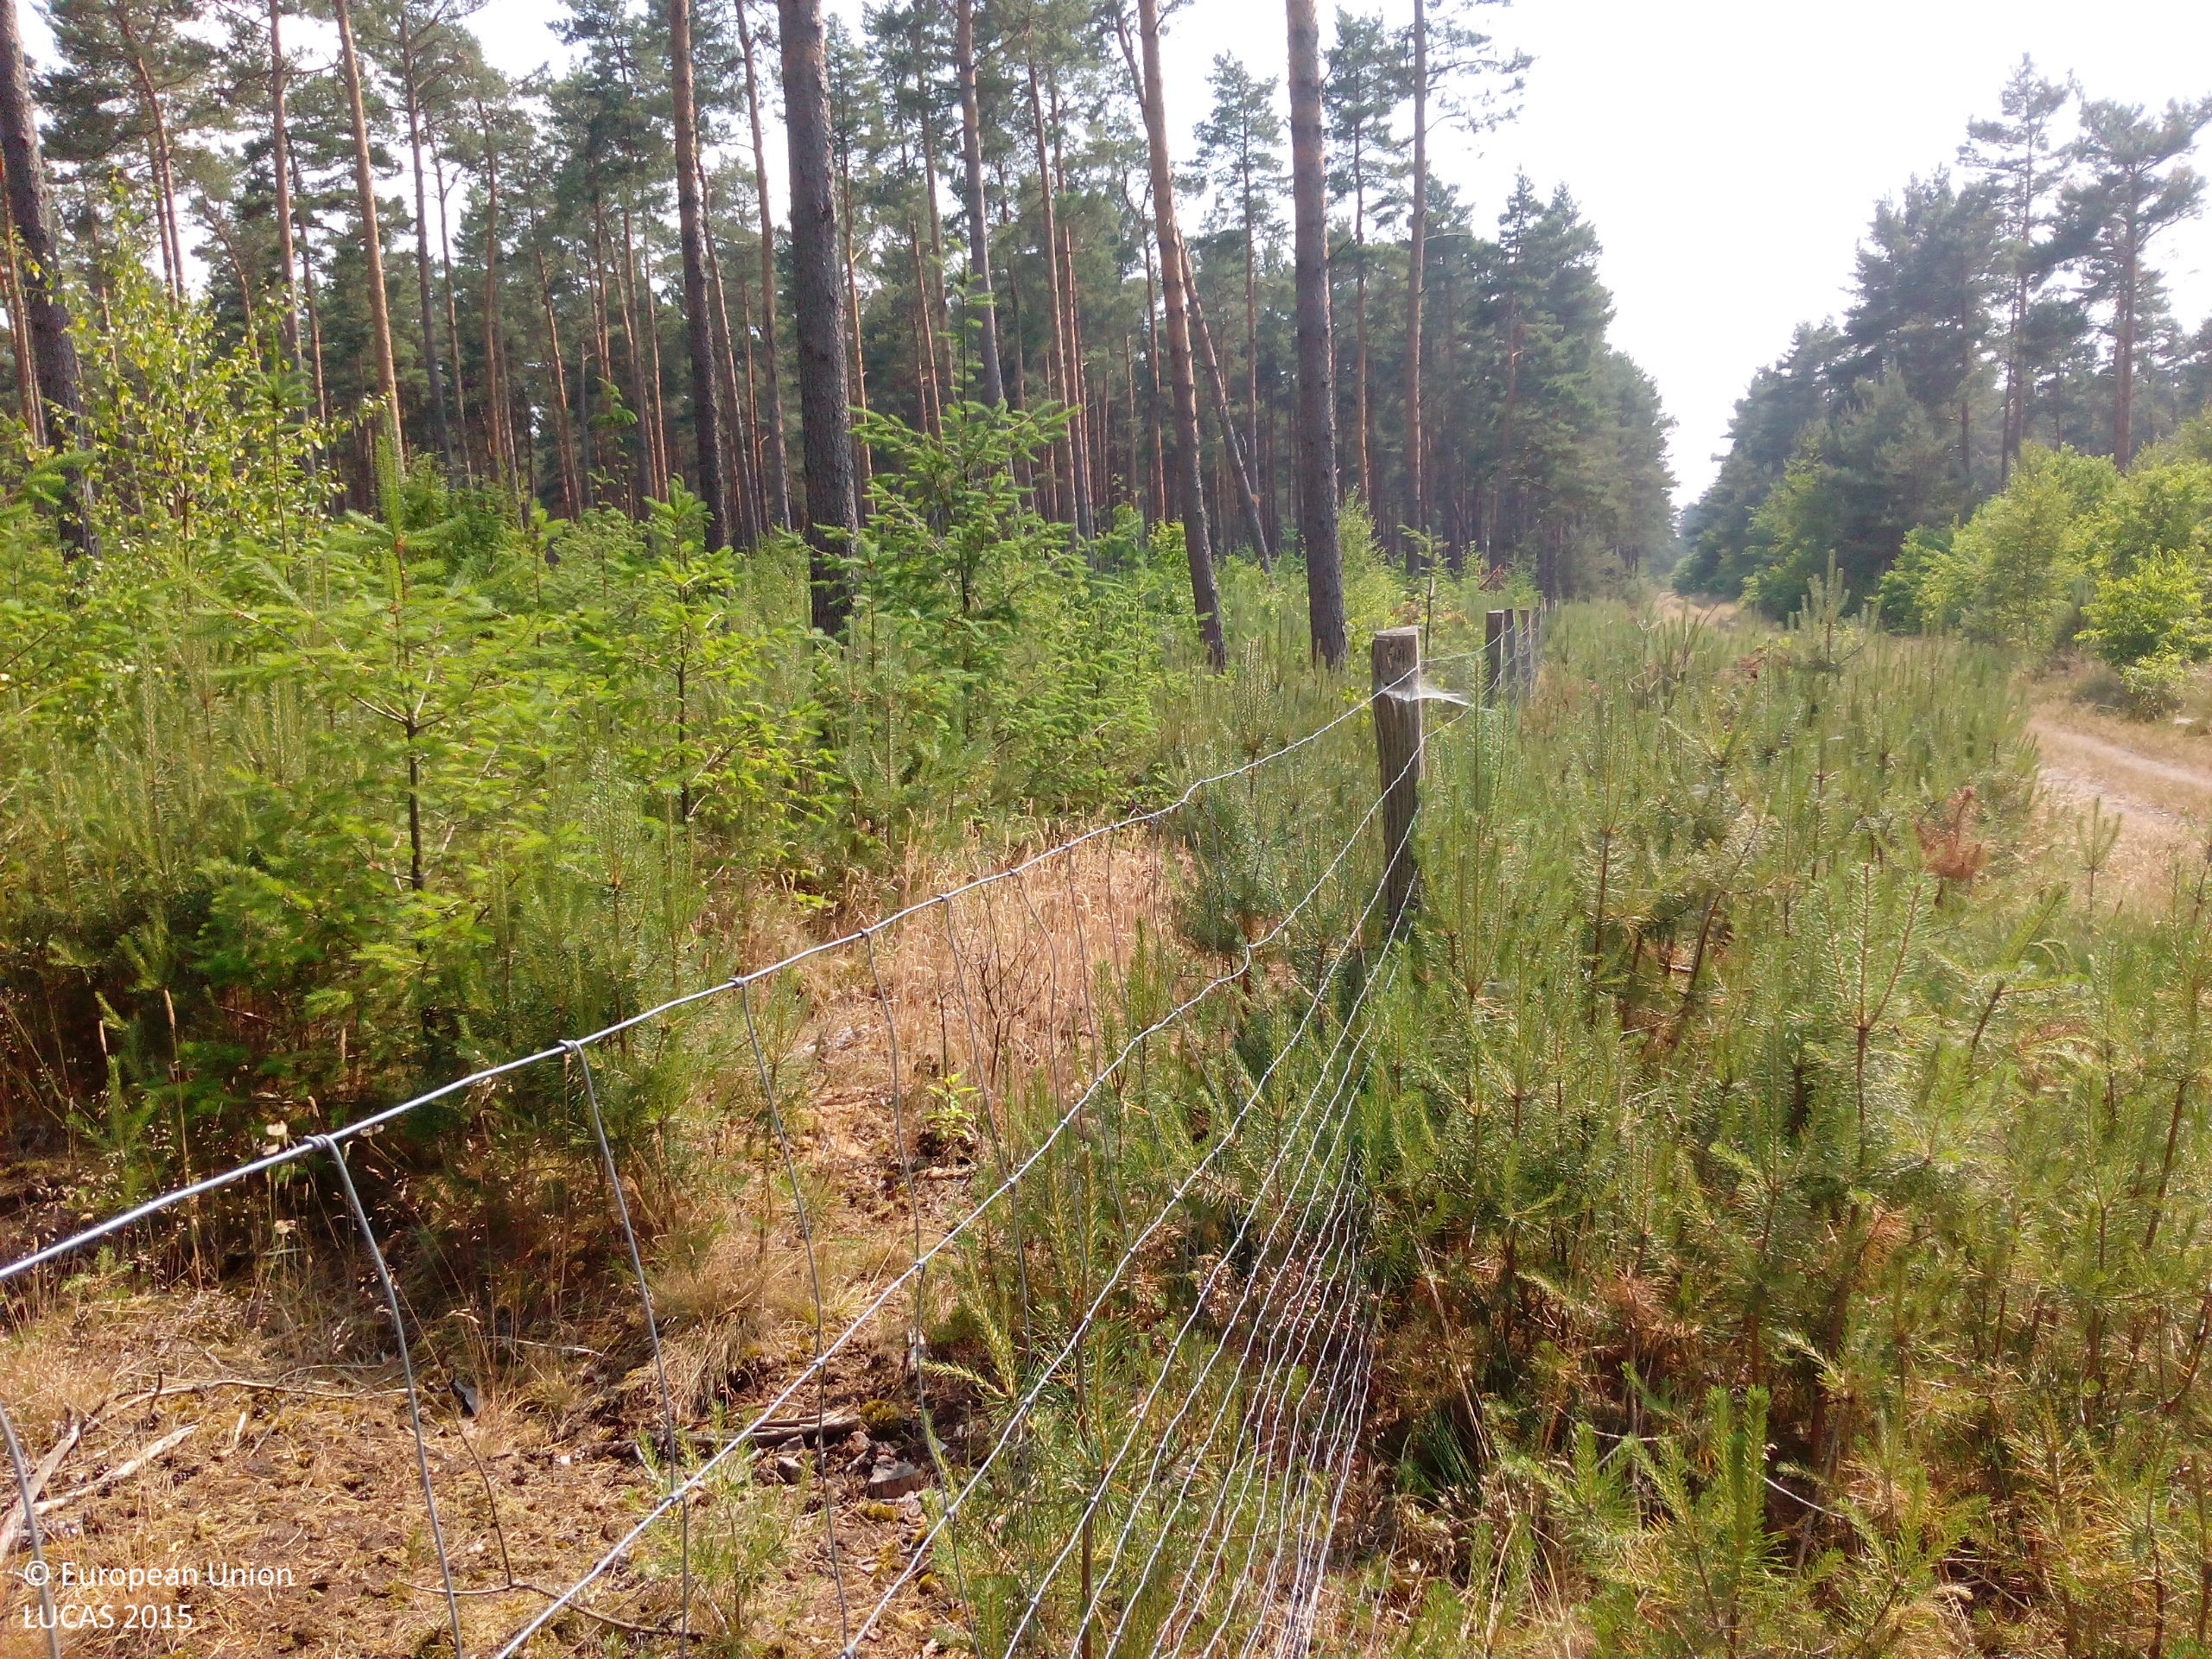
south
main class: Woodland
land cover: Other coniferous woodland
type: hemiboreal forest and nemoral coniferous forest and mixed broadleaved-coniferous forest
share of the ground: > 75 %
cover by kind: coniferous forest trees 80 %, broadleaved forest trees 10 %, herbaceous plants 10 %
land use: Forestry
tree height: > 5 m
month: July
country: DE
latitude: 52.5911
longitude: 10.6935
